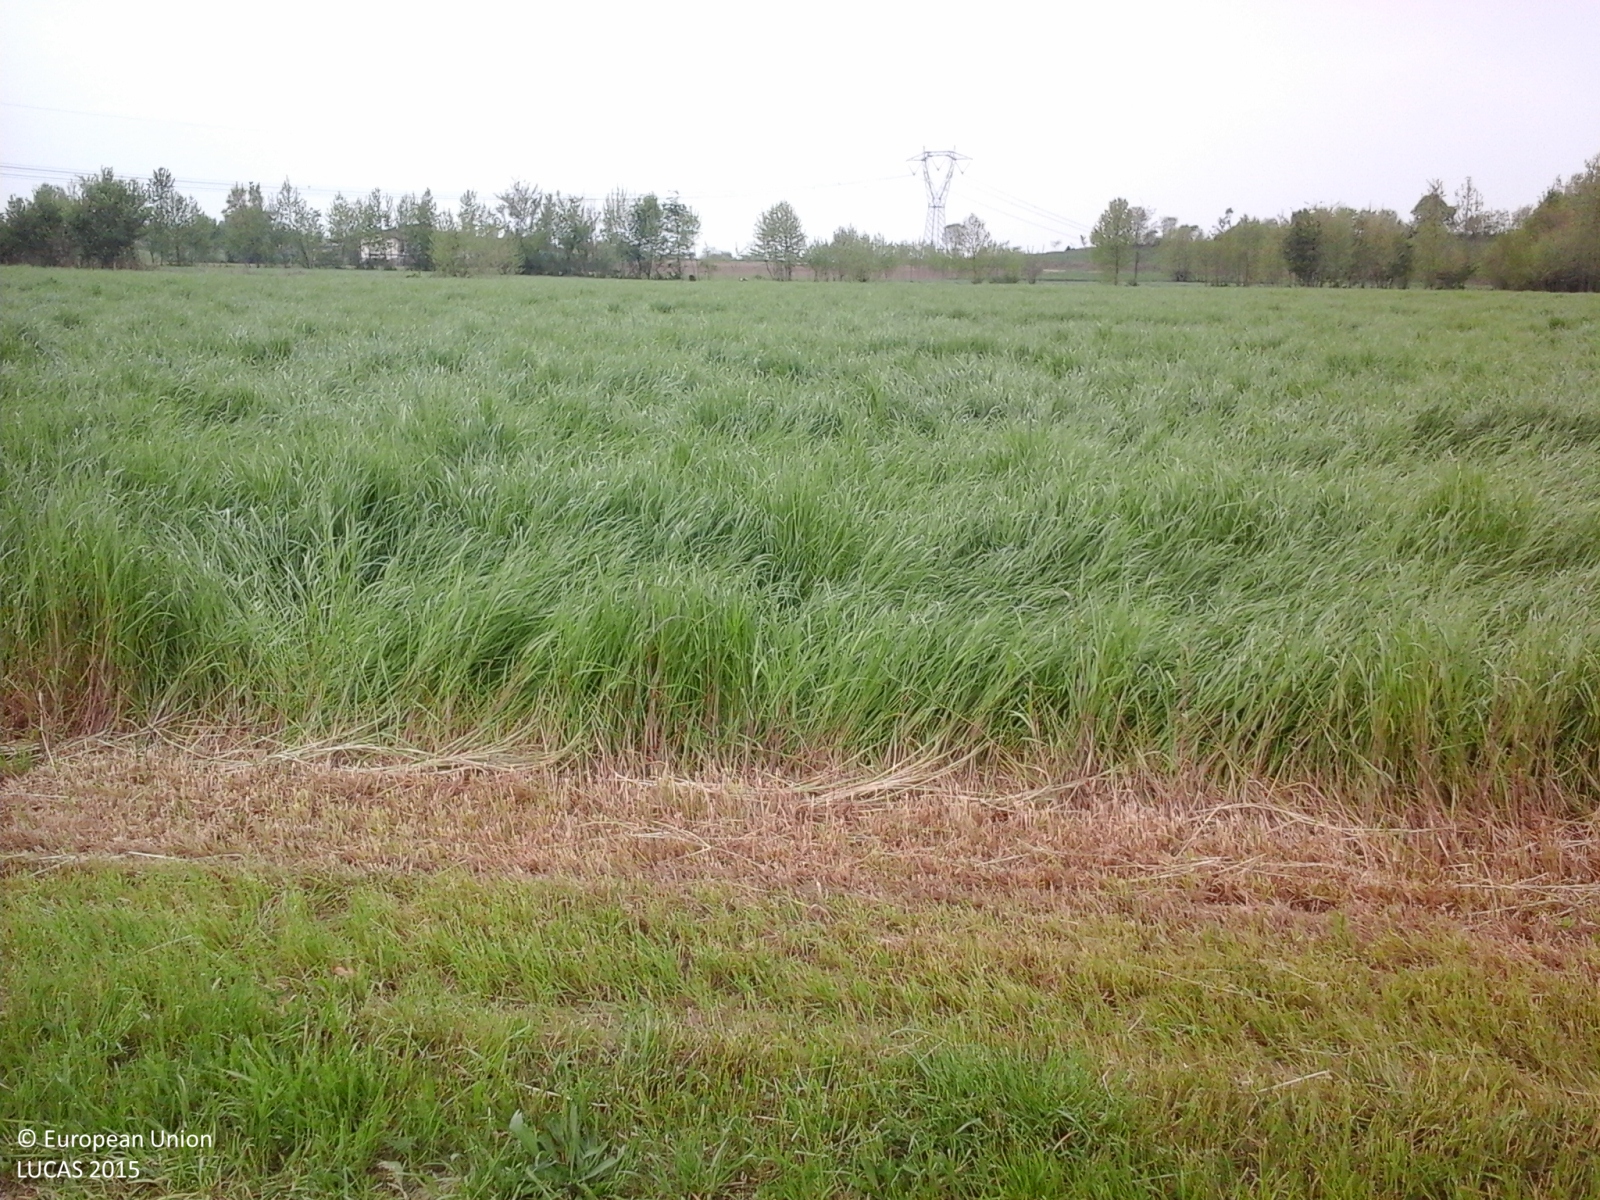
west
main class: Cropland
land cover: Maize
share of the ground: < 10 %
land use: Agriculture (excluding fallow land and kitchen gardens)
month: April
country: IT
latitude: 45.3762
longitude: 10.6501
